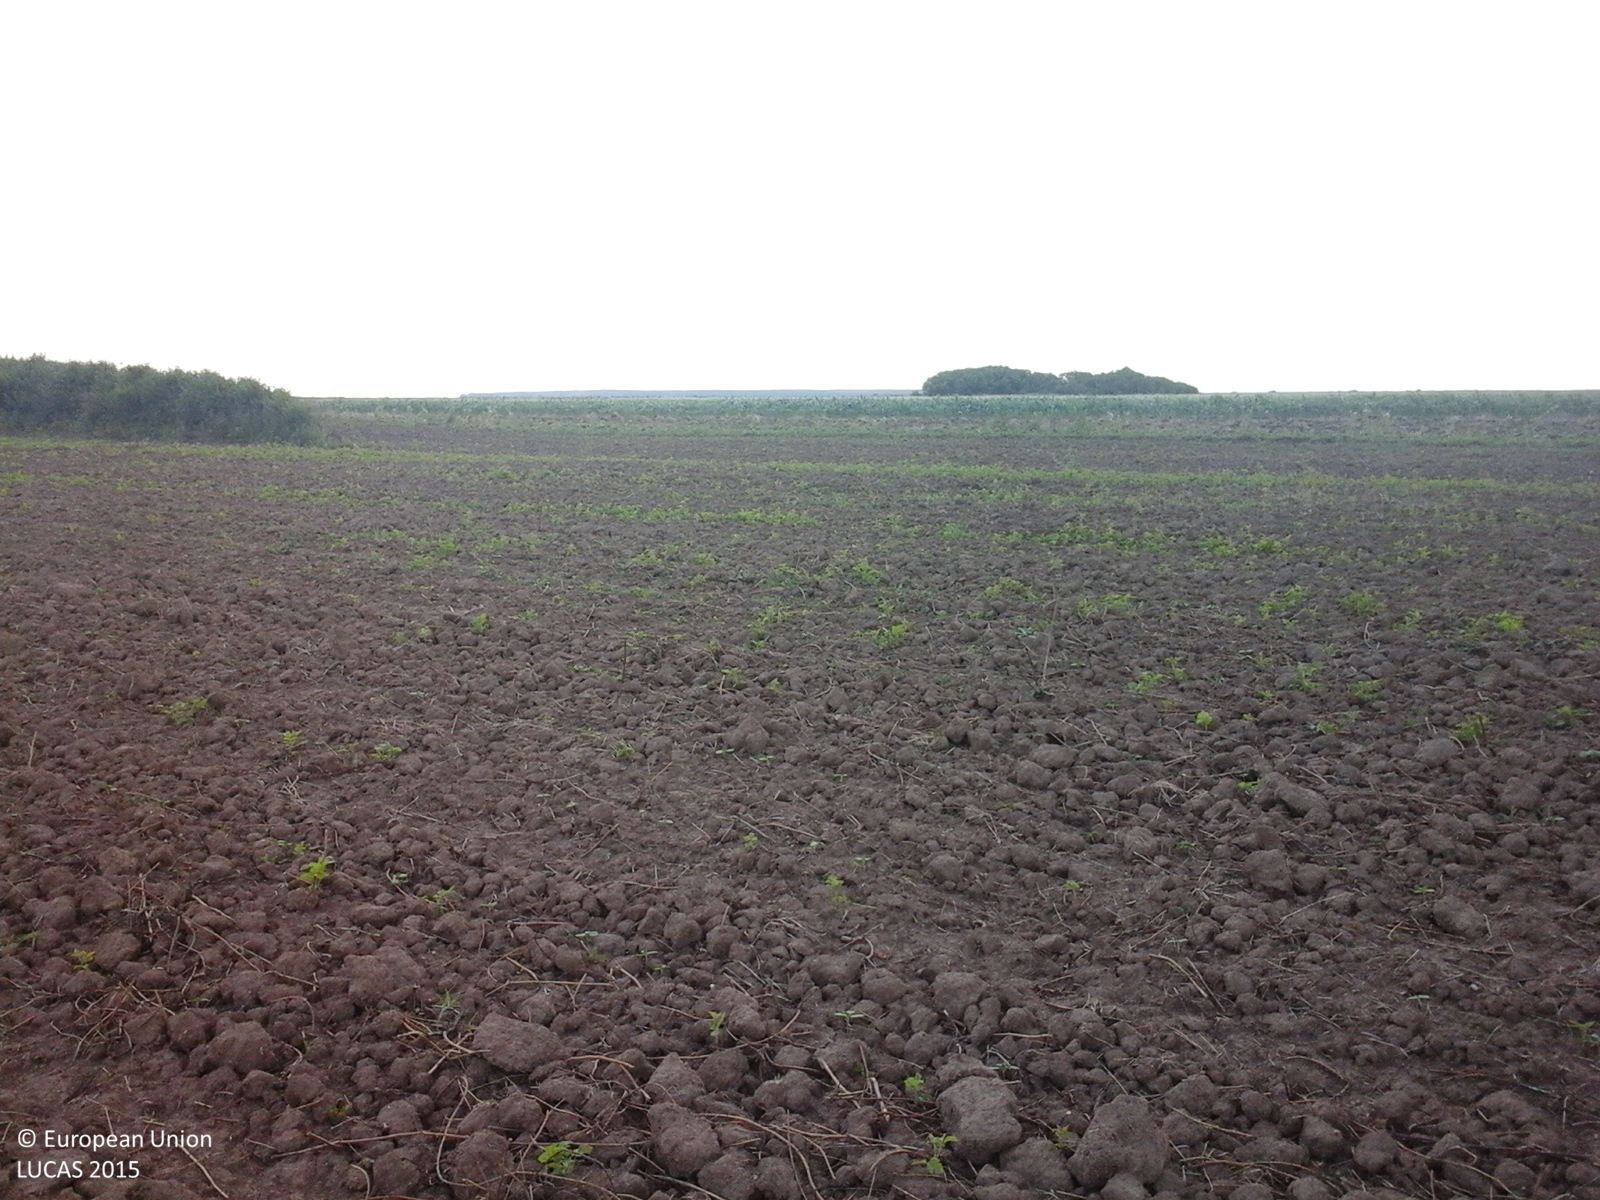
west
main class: Cropland
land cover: Sunflower
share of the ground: < 10 %
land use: Agriculture (excluding fallow land and kitchen gardens)
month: July
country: RO
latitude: 44.3387
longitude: 25.5819
